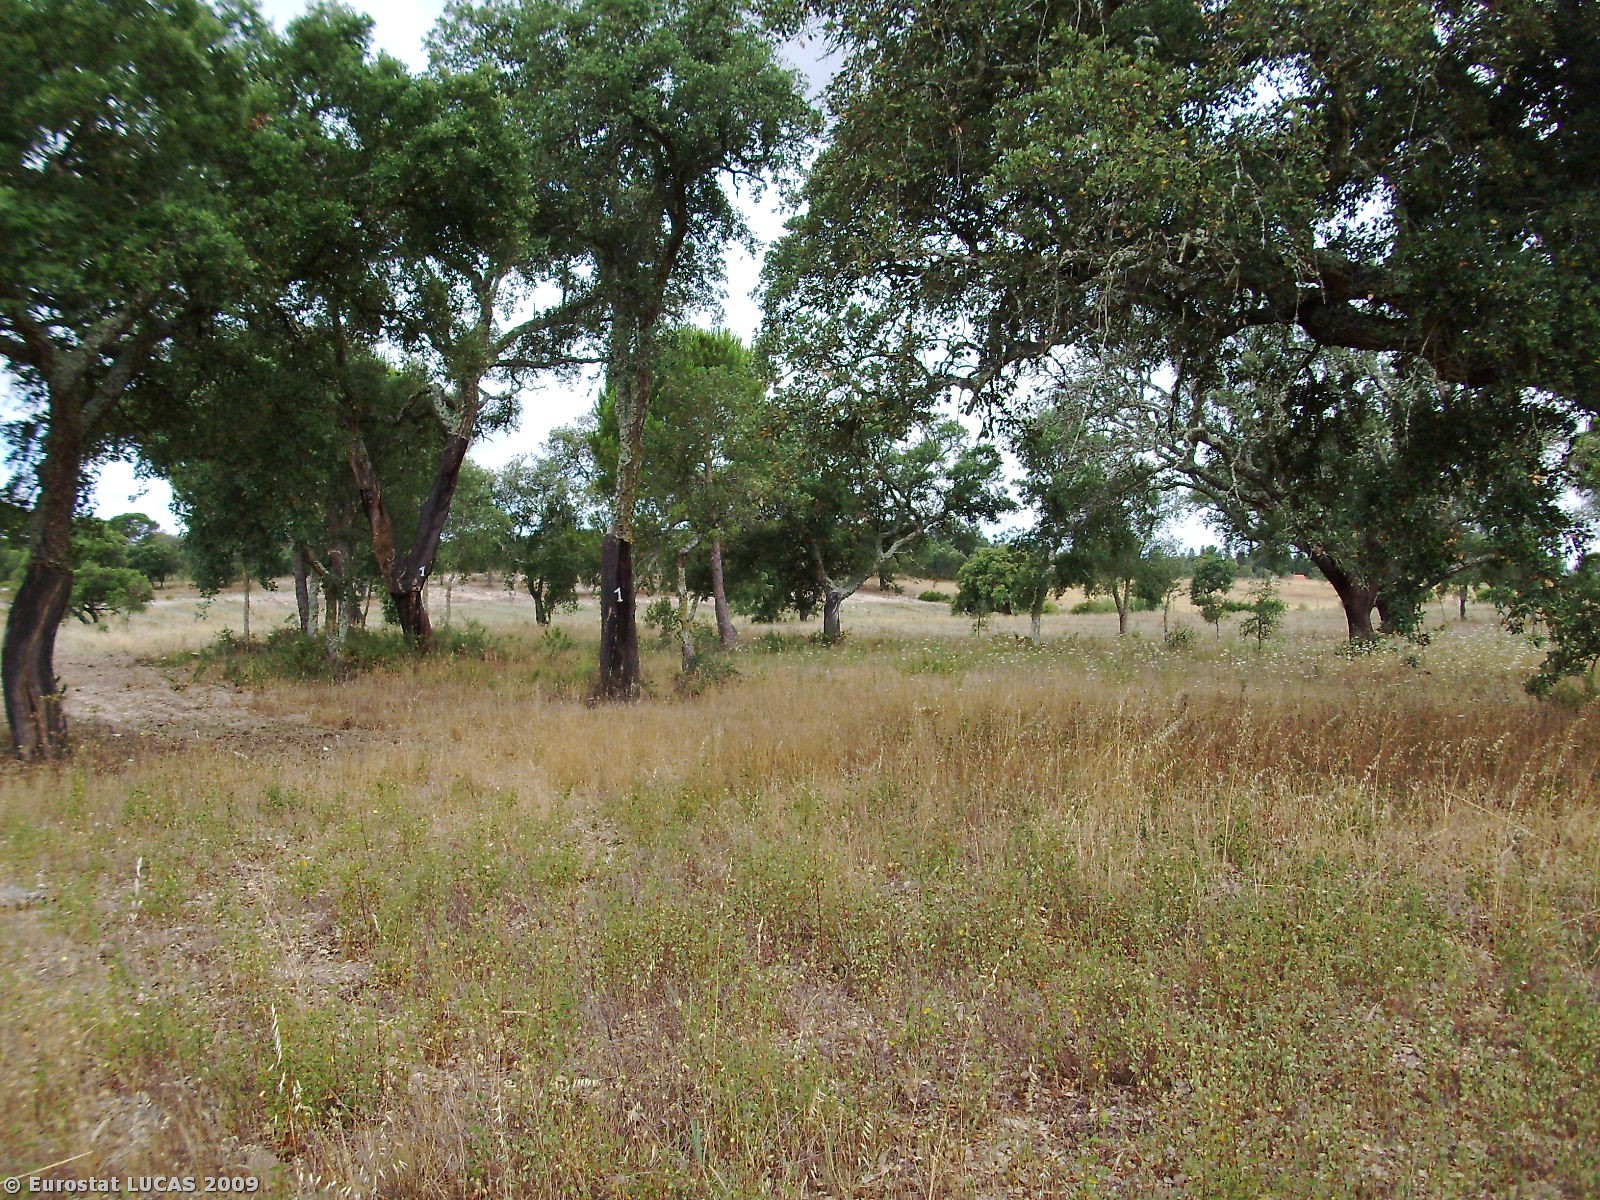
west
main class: Woodland
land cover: Broadleaved woodland
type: broadleaved evergreen forest
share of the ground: 10 - 25 %
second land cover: Bare land
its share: 10 - 25 %
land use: Forestry
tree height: > 5 m
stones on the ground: < 10 %
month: June
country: PT
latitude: 38.2976
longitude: -8.5395
